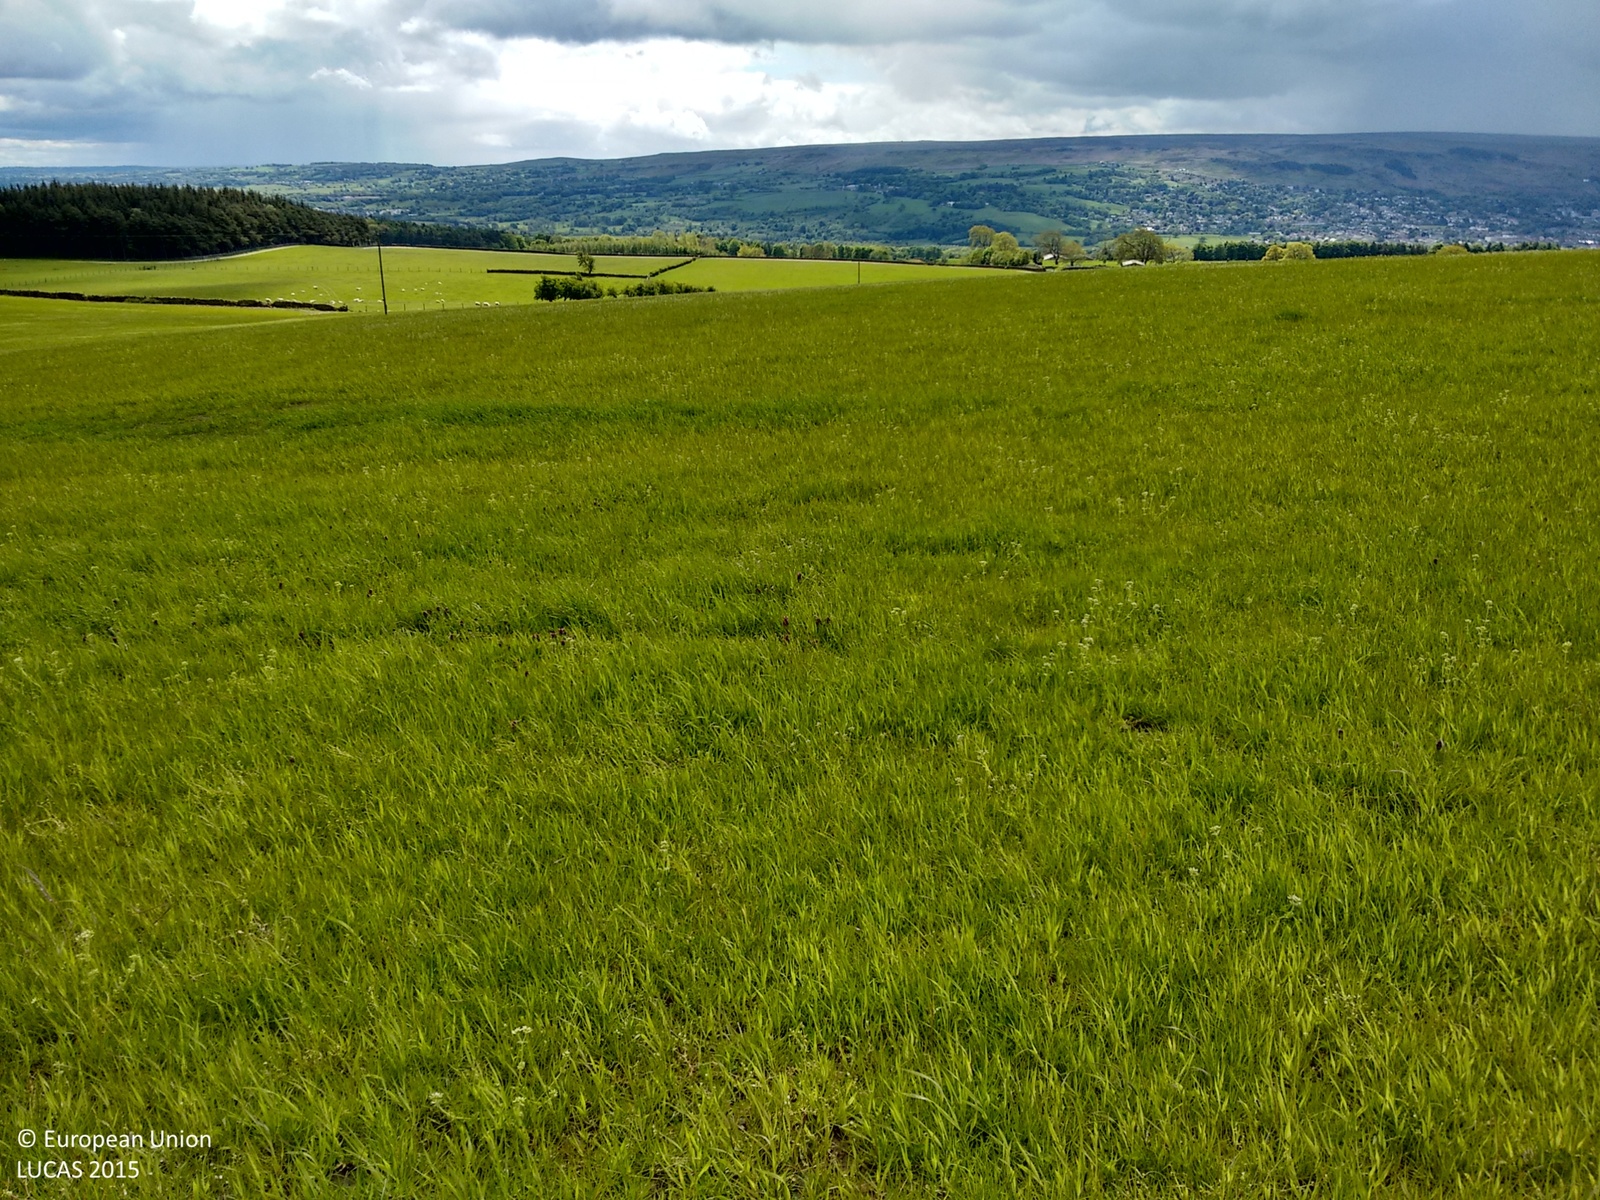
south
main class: Grassland
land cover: Grassland without tree/shrub cover
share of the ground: > 75 %
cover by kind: herbaceous plants 100 %
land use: Agriculture (excluding fallow land and kitchen gardens)
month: May
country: GB
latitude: 53.9525
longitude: -1.7716
